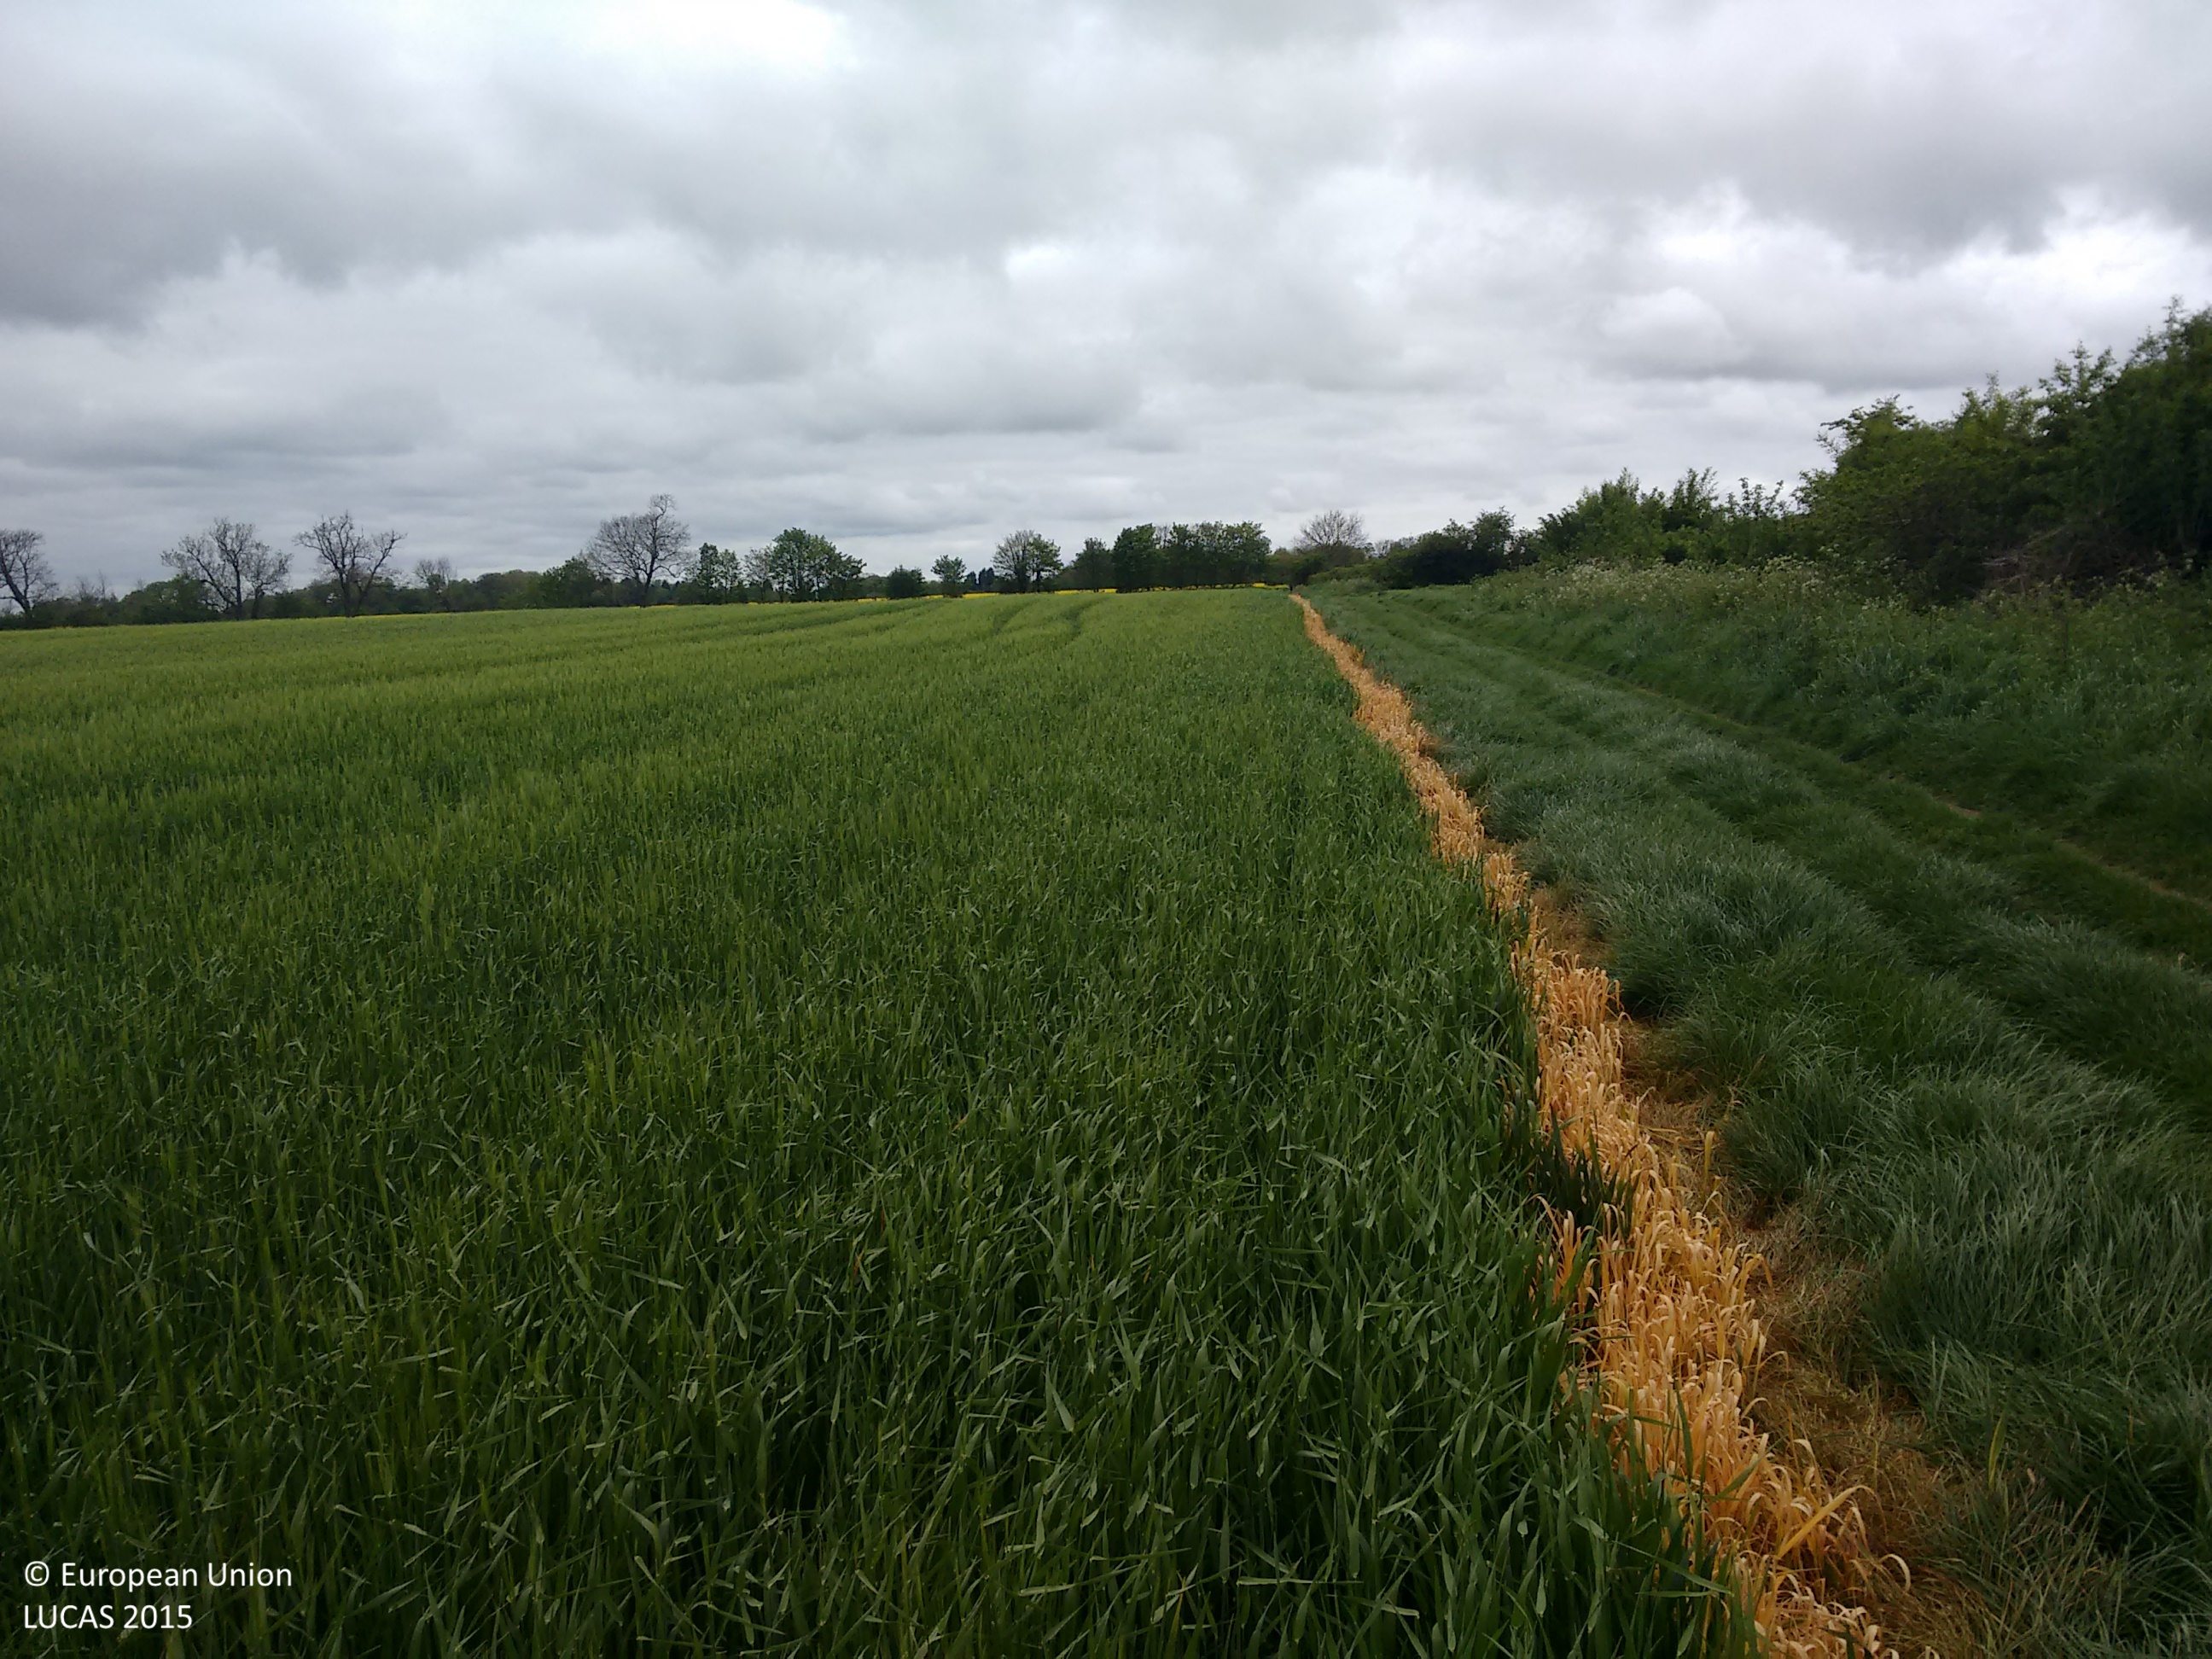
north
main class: Cropland
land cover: Barley
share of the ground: > 75 %
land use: Agriculture (excluding fallow land and kitchen gardens)
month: May
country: GB
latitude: 53.7818
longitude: -0.2477
